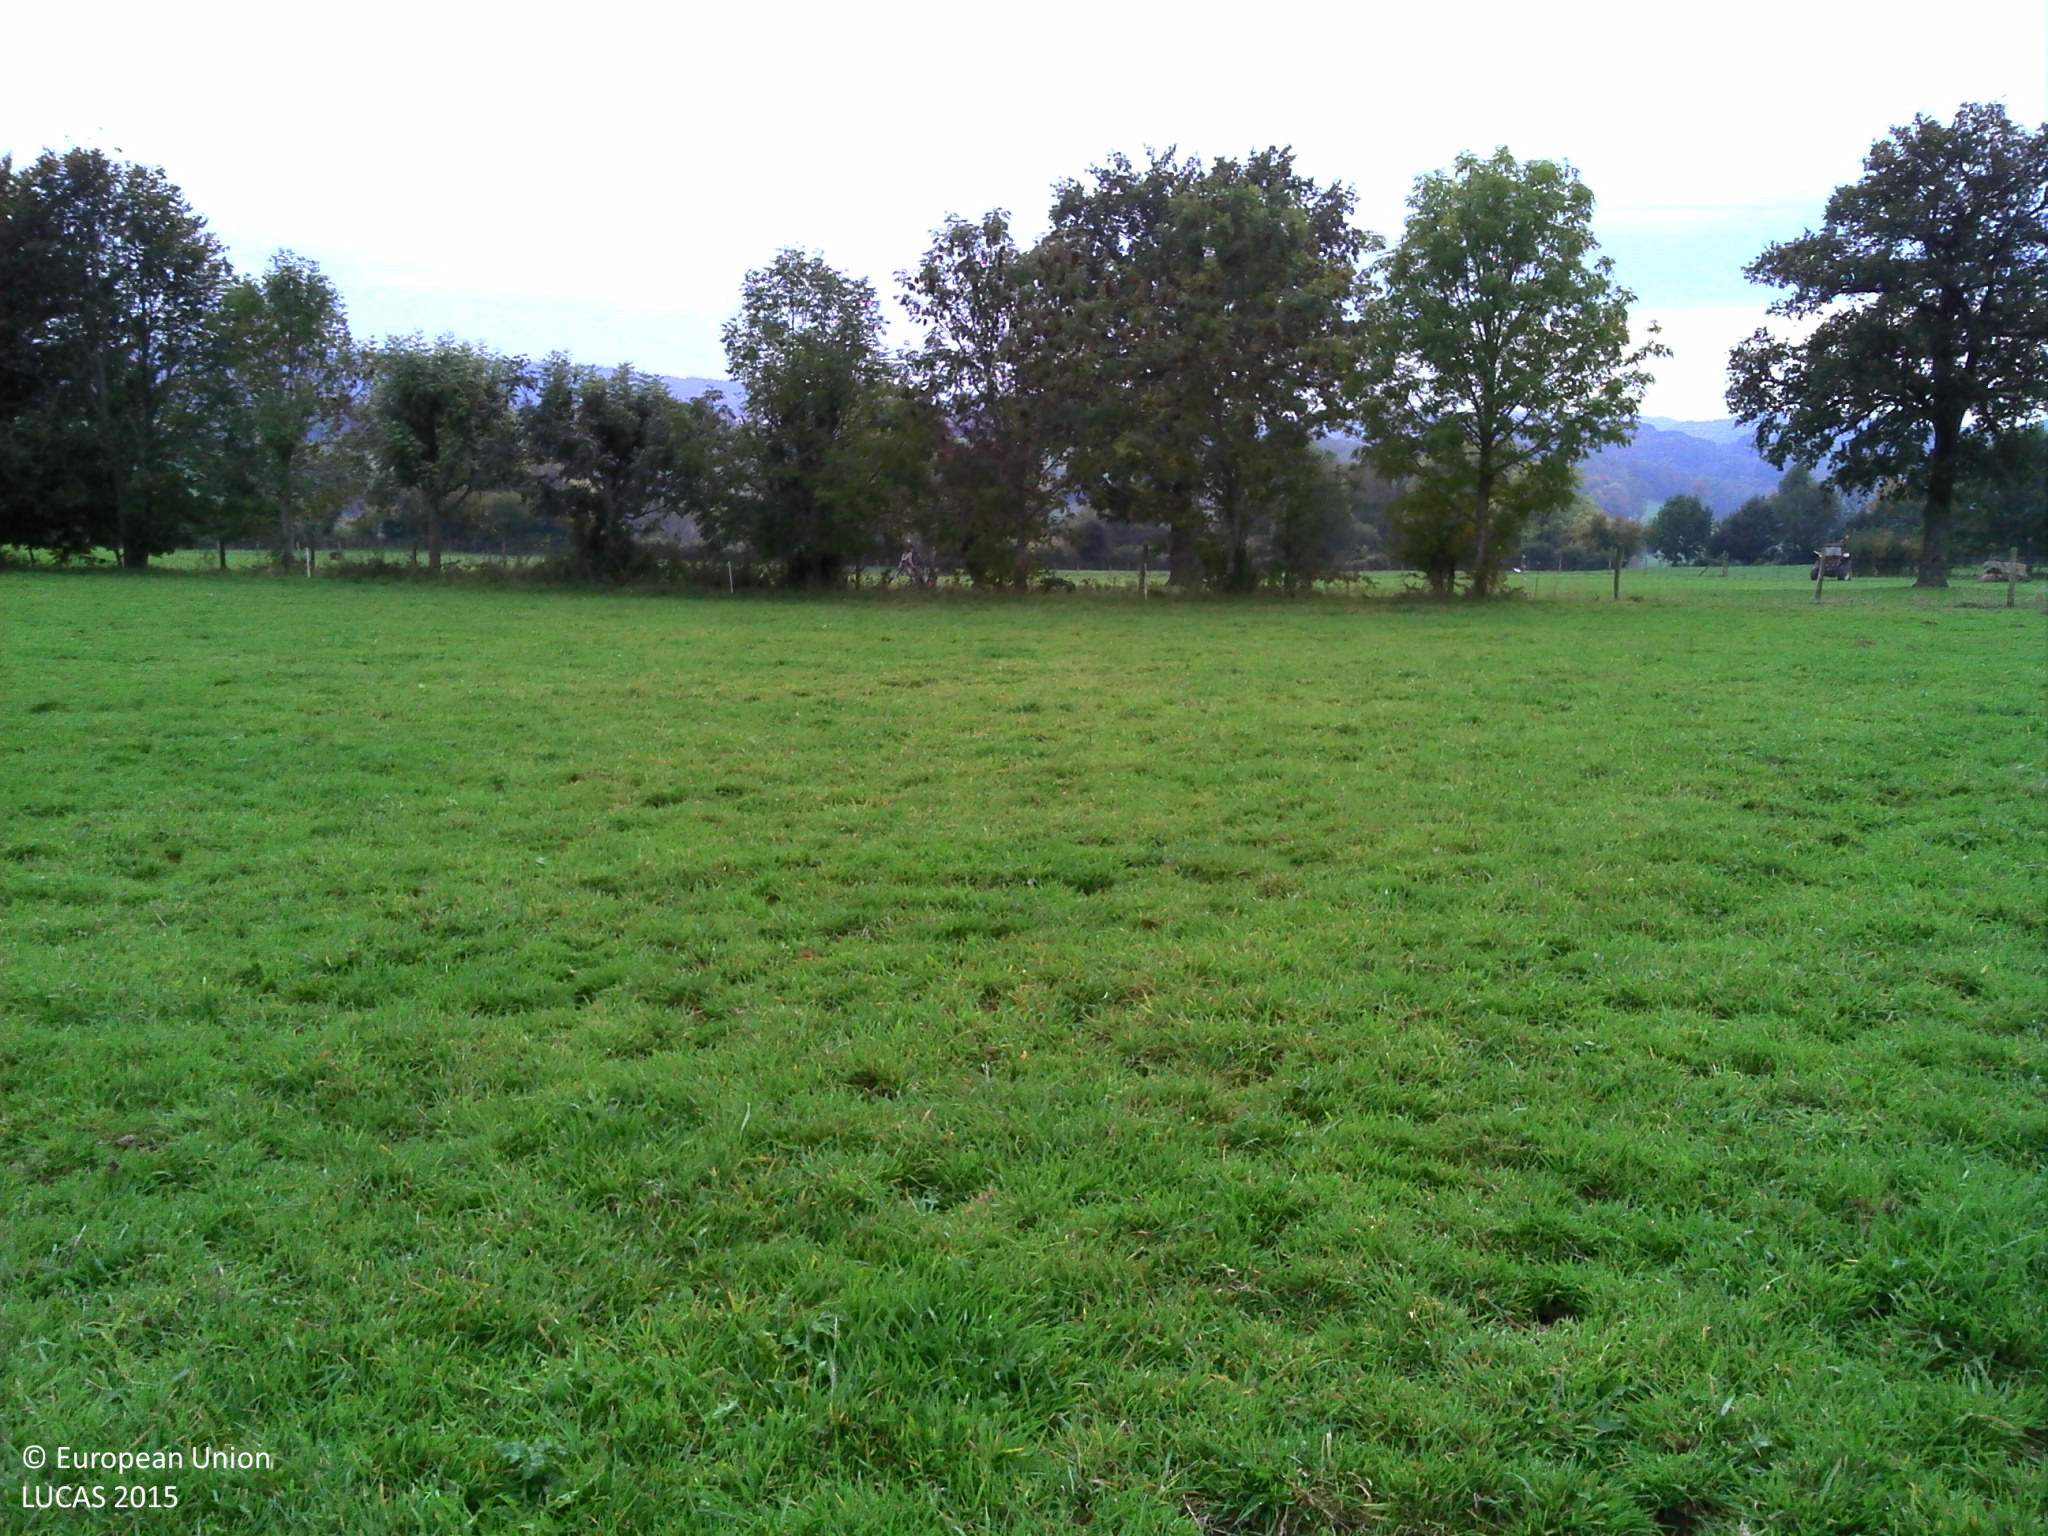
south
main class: Grassland
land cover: Grassland without tree/shrub cover
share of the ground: > 75 %
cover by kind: herbaceous plants 100 %
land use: Agriculture (excluding fallow land and kitchen gardens)
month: October
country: FR
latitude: 46.1598
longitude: 2.7583
